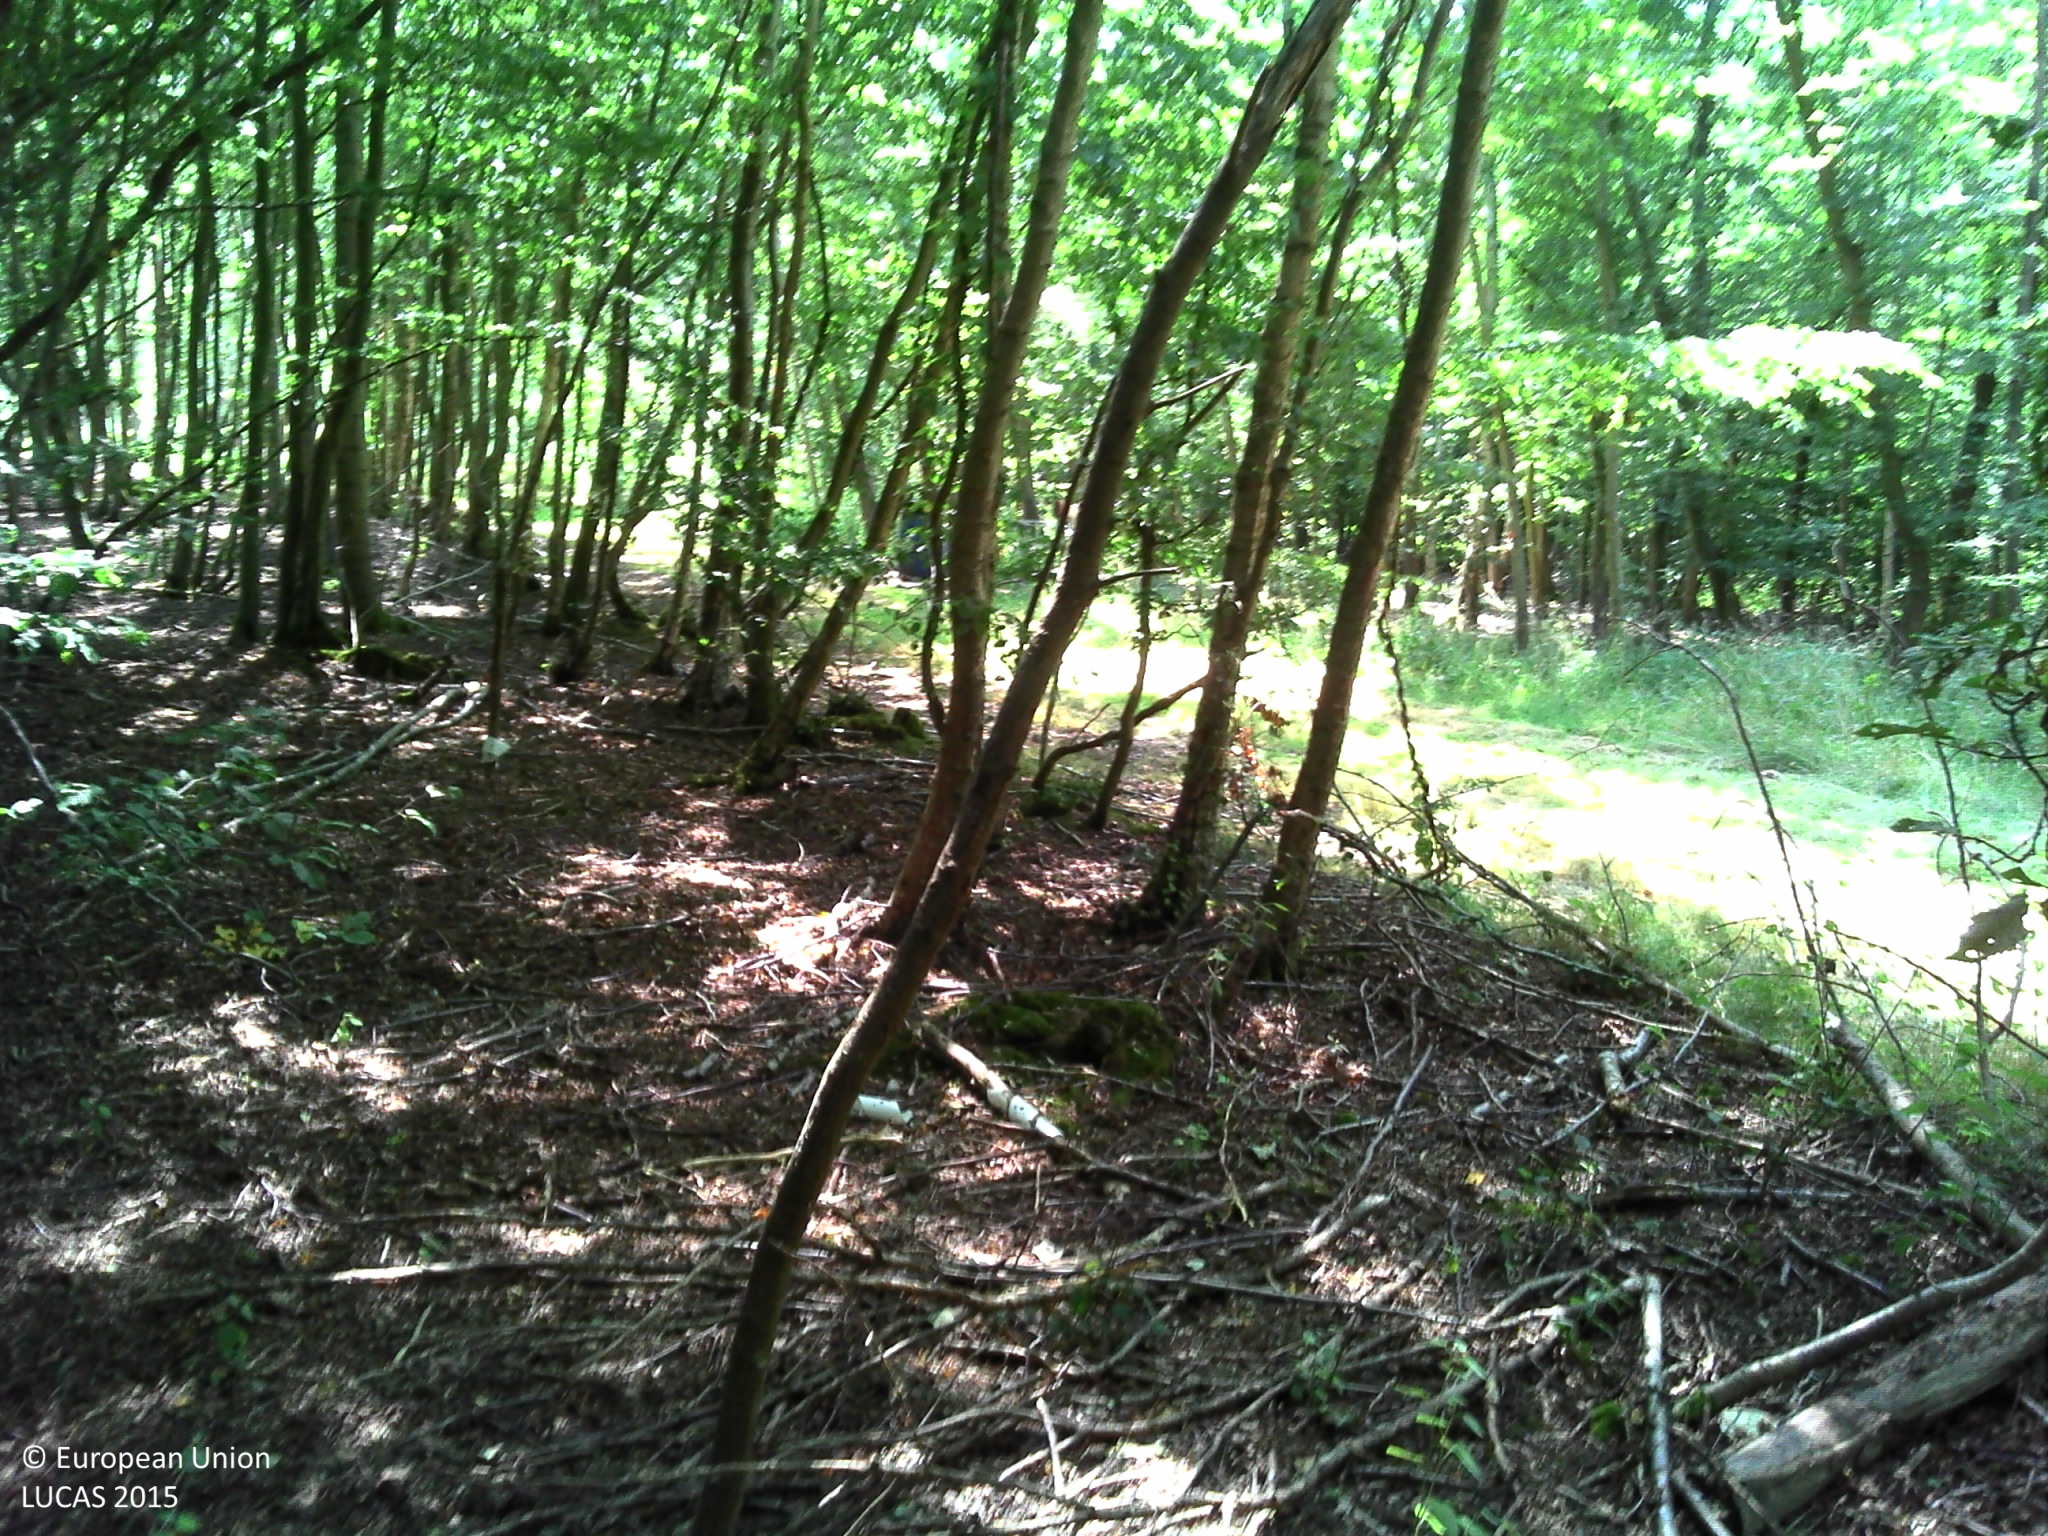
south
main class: Woodland
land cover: Broadleaved woodland
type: mesophytic deciduous forest
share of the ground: > 75 %
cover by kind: broadleaved forest trees 90 %, lichens and mosses 5 %, unconsolidated bare surface 5 %
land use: Forestry
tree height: > 5 m
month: August
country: FR
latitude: 50.8615
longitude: 2.0139
